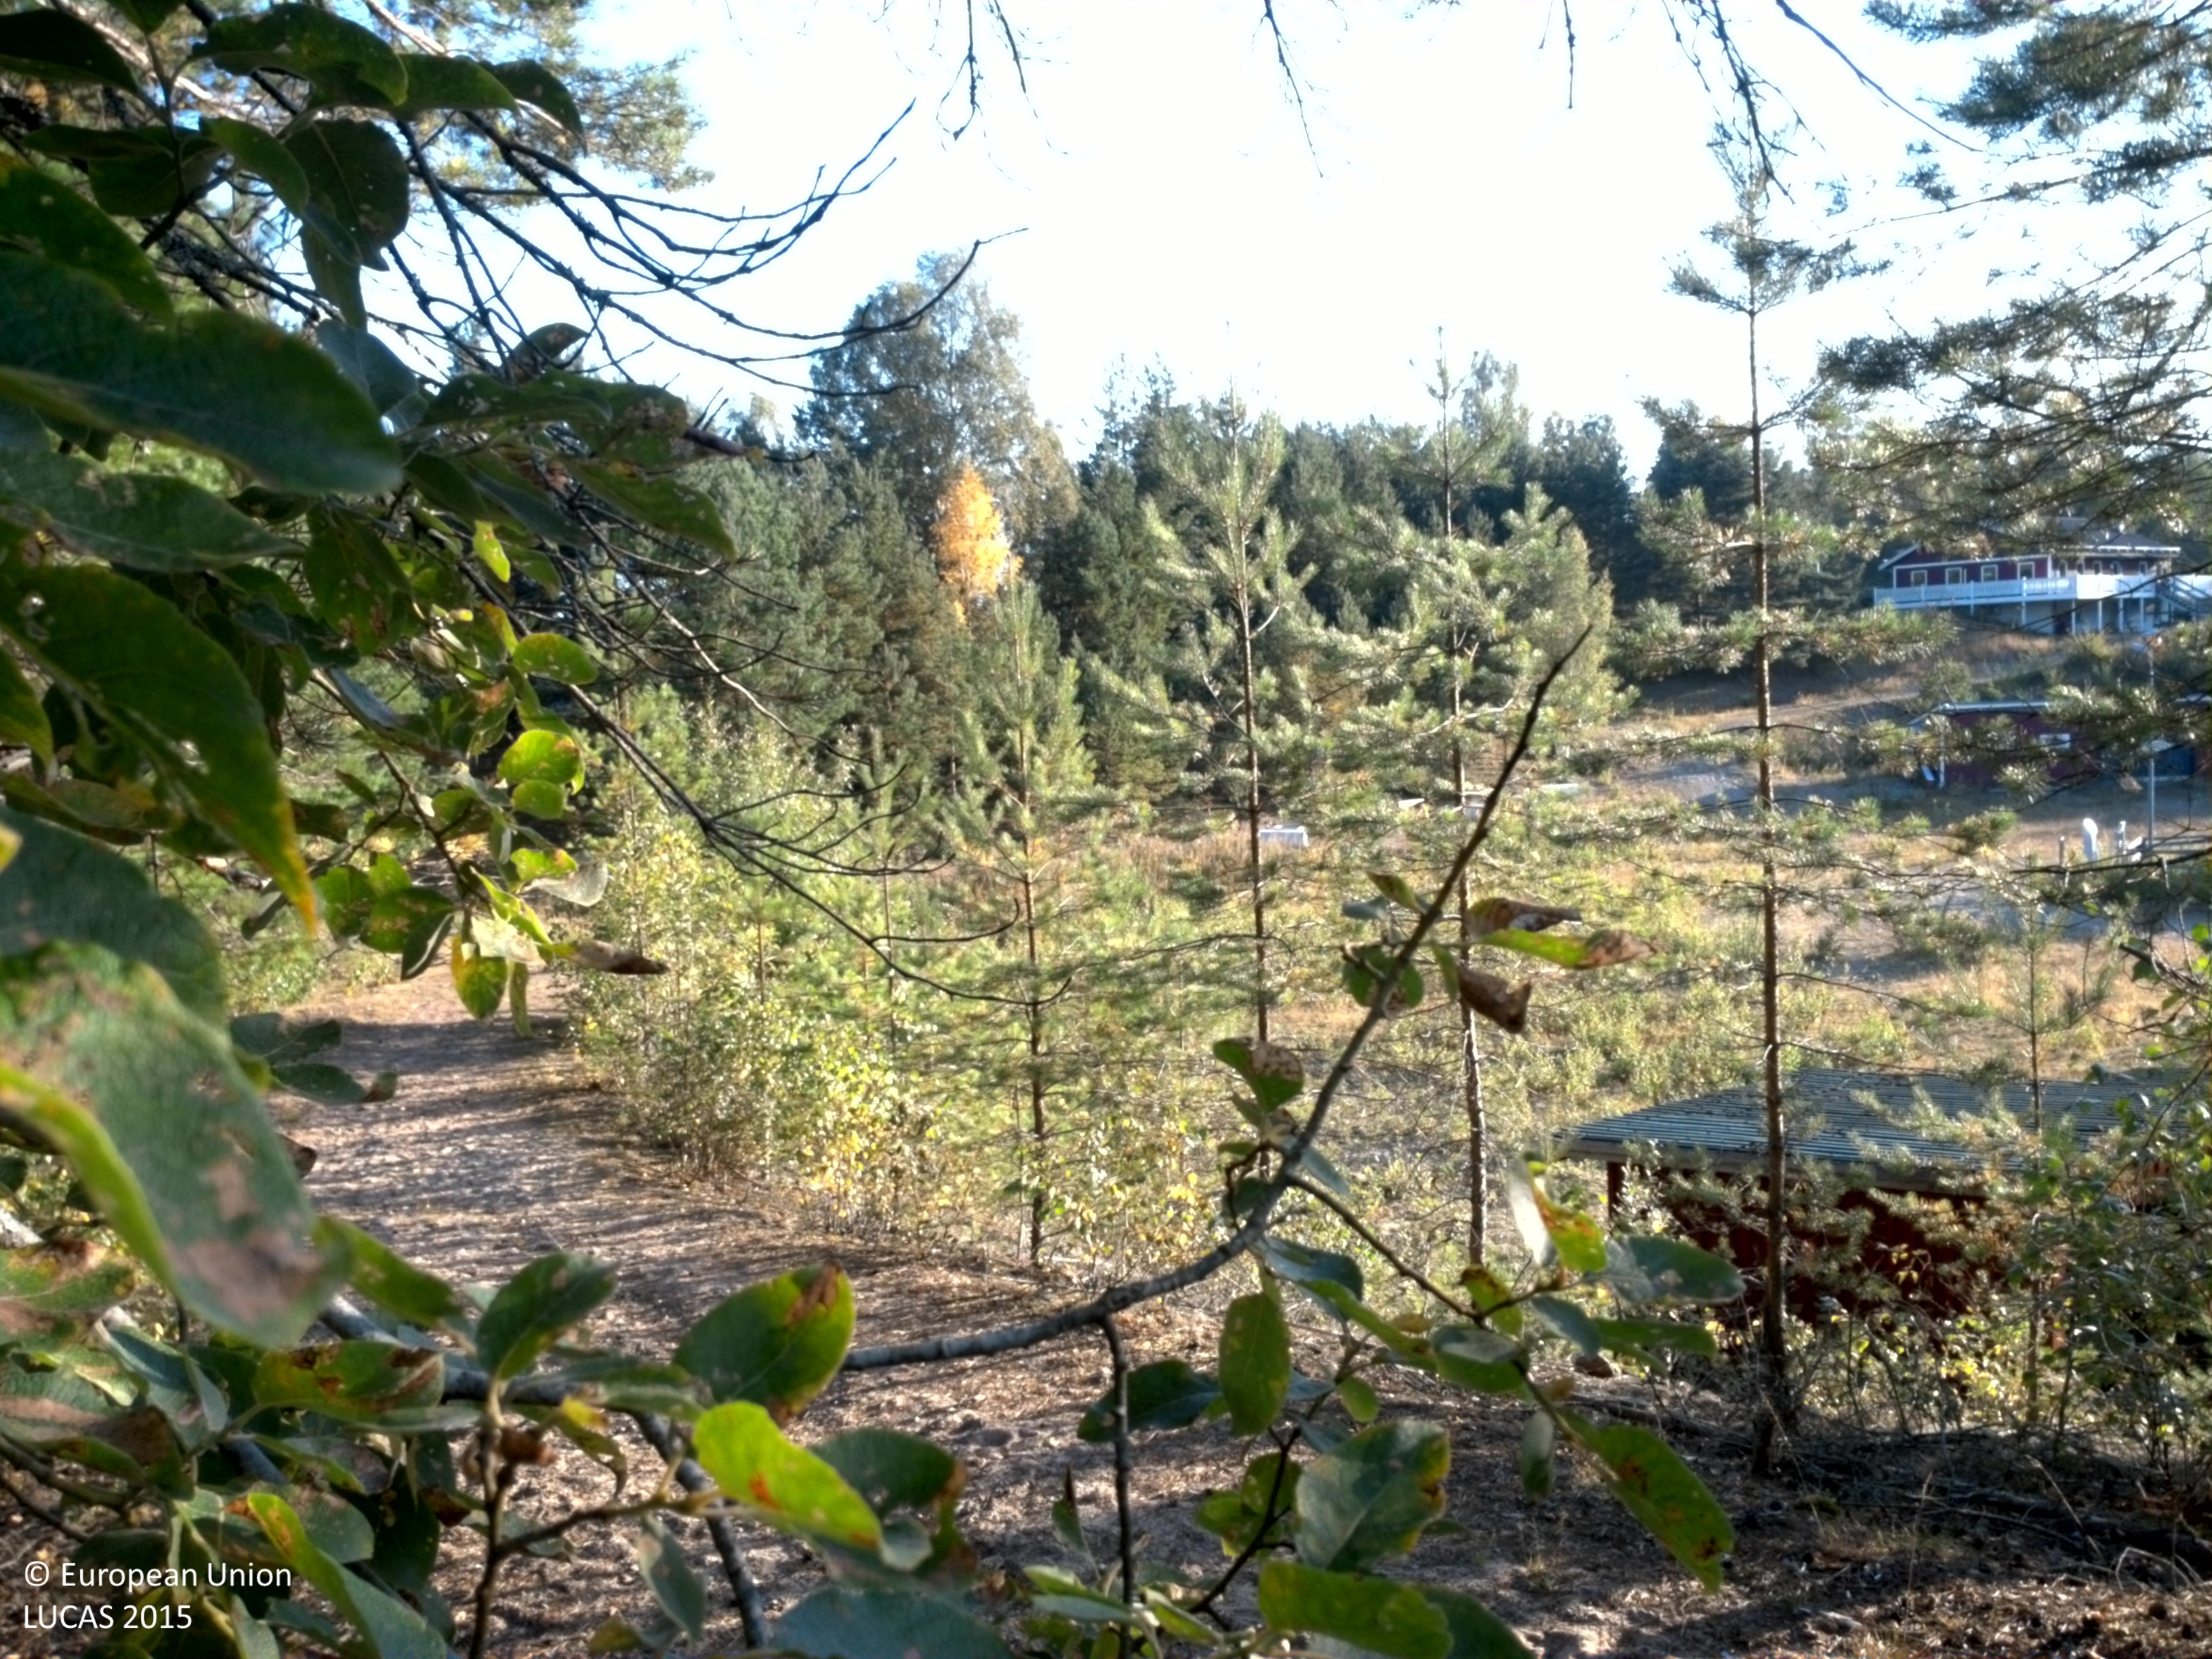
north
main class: Woodland
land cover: Pine dominated mixed woodland
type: boreal forest
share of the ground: 25 - 50 %
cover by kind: coniferous forest trees 35 %, lichens and mosses 25 %, consolidated bare surface 20 %, broadleaved forest trees 15 %, herbaceous plants 5 %
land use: Sport
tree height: > 5 m
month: August
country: SE
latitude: 59.5288
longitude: 13.3335
